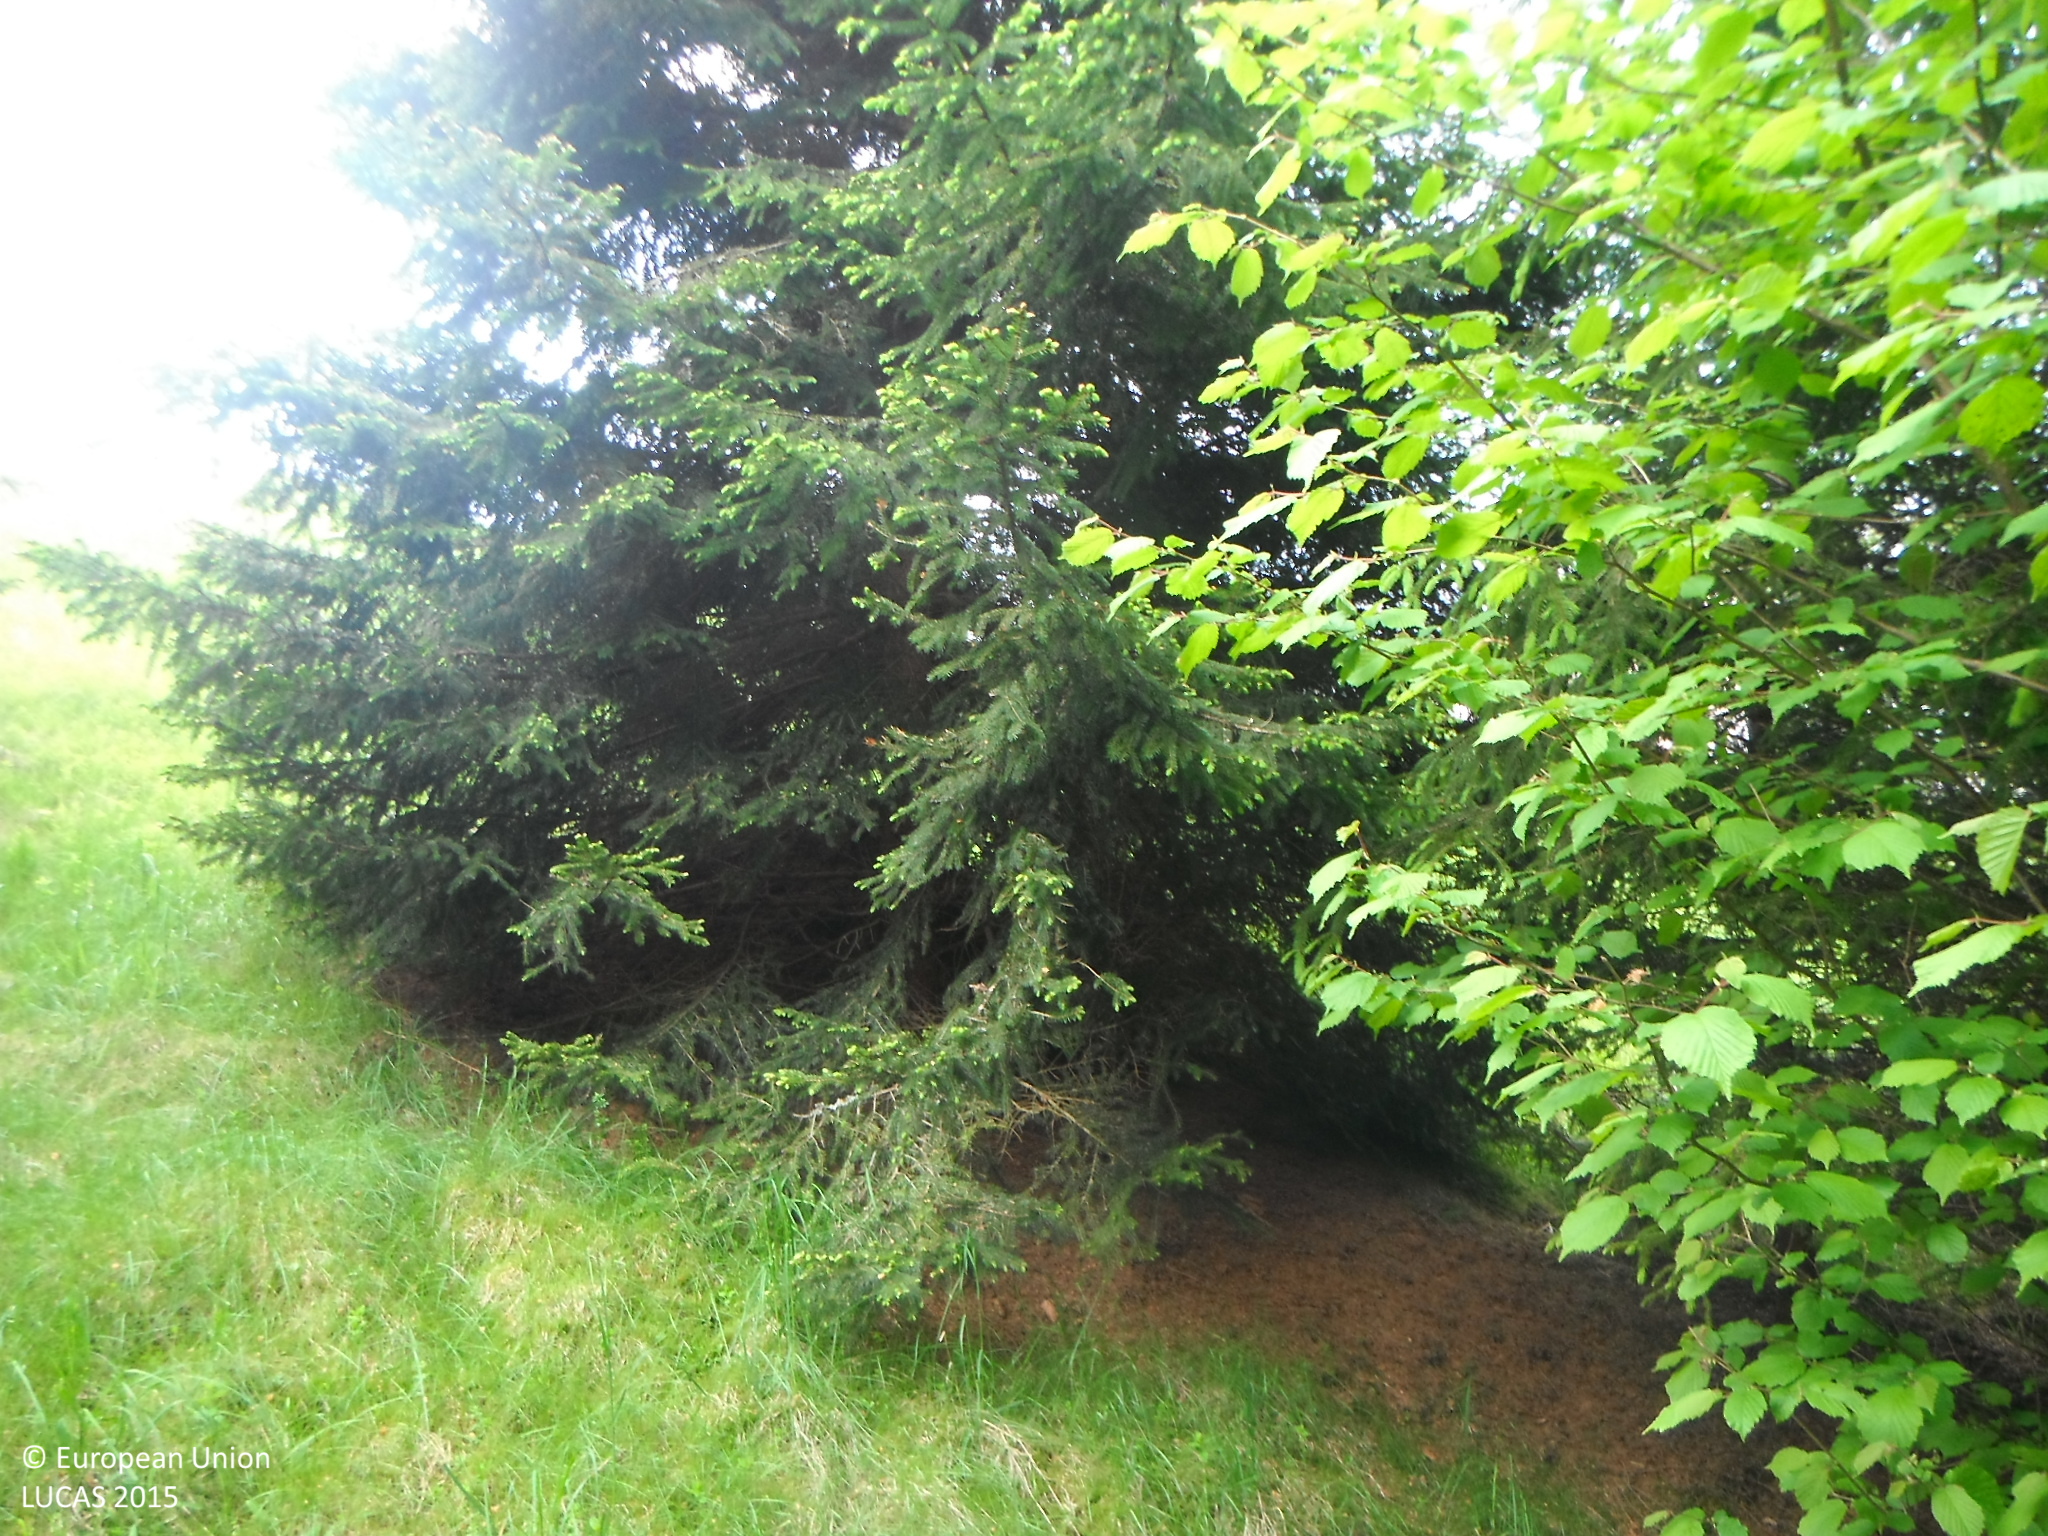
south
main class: Woodland
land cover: Other mixed woodland
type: hemiboreal forest and nemoral coniferous forest and mixed broadleaved-coniferous forest
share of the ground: > 75 %
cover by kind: broadleaved forest trees 60 %, coniferous forest trees 40 %
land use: Forestry
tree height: > 5 m
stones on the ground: 10 - 25 %
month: June
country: SK
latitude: 49.0952
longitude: 20.7348
